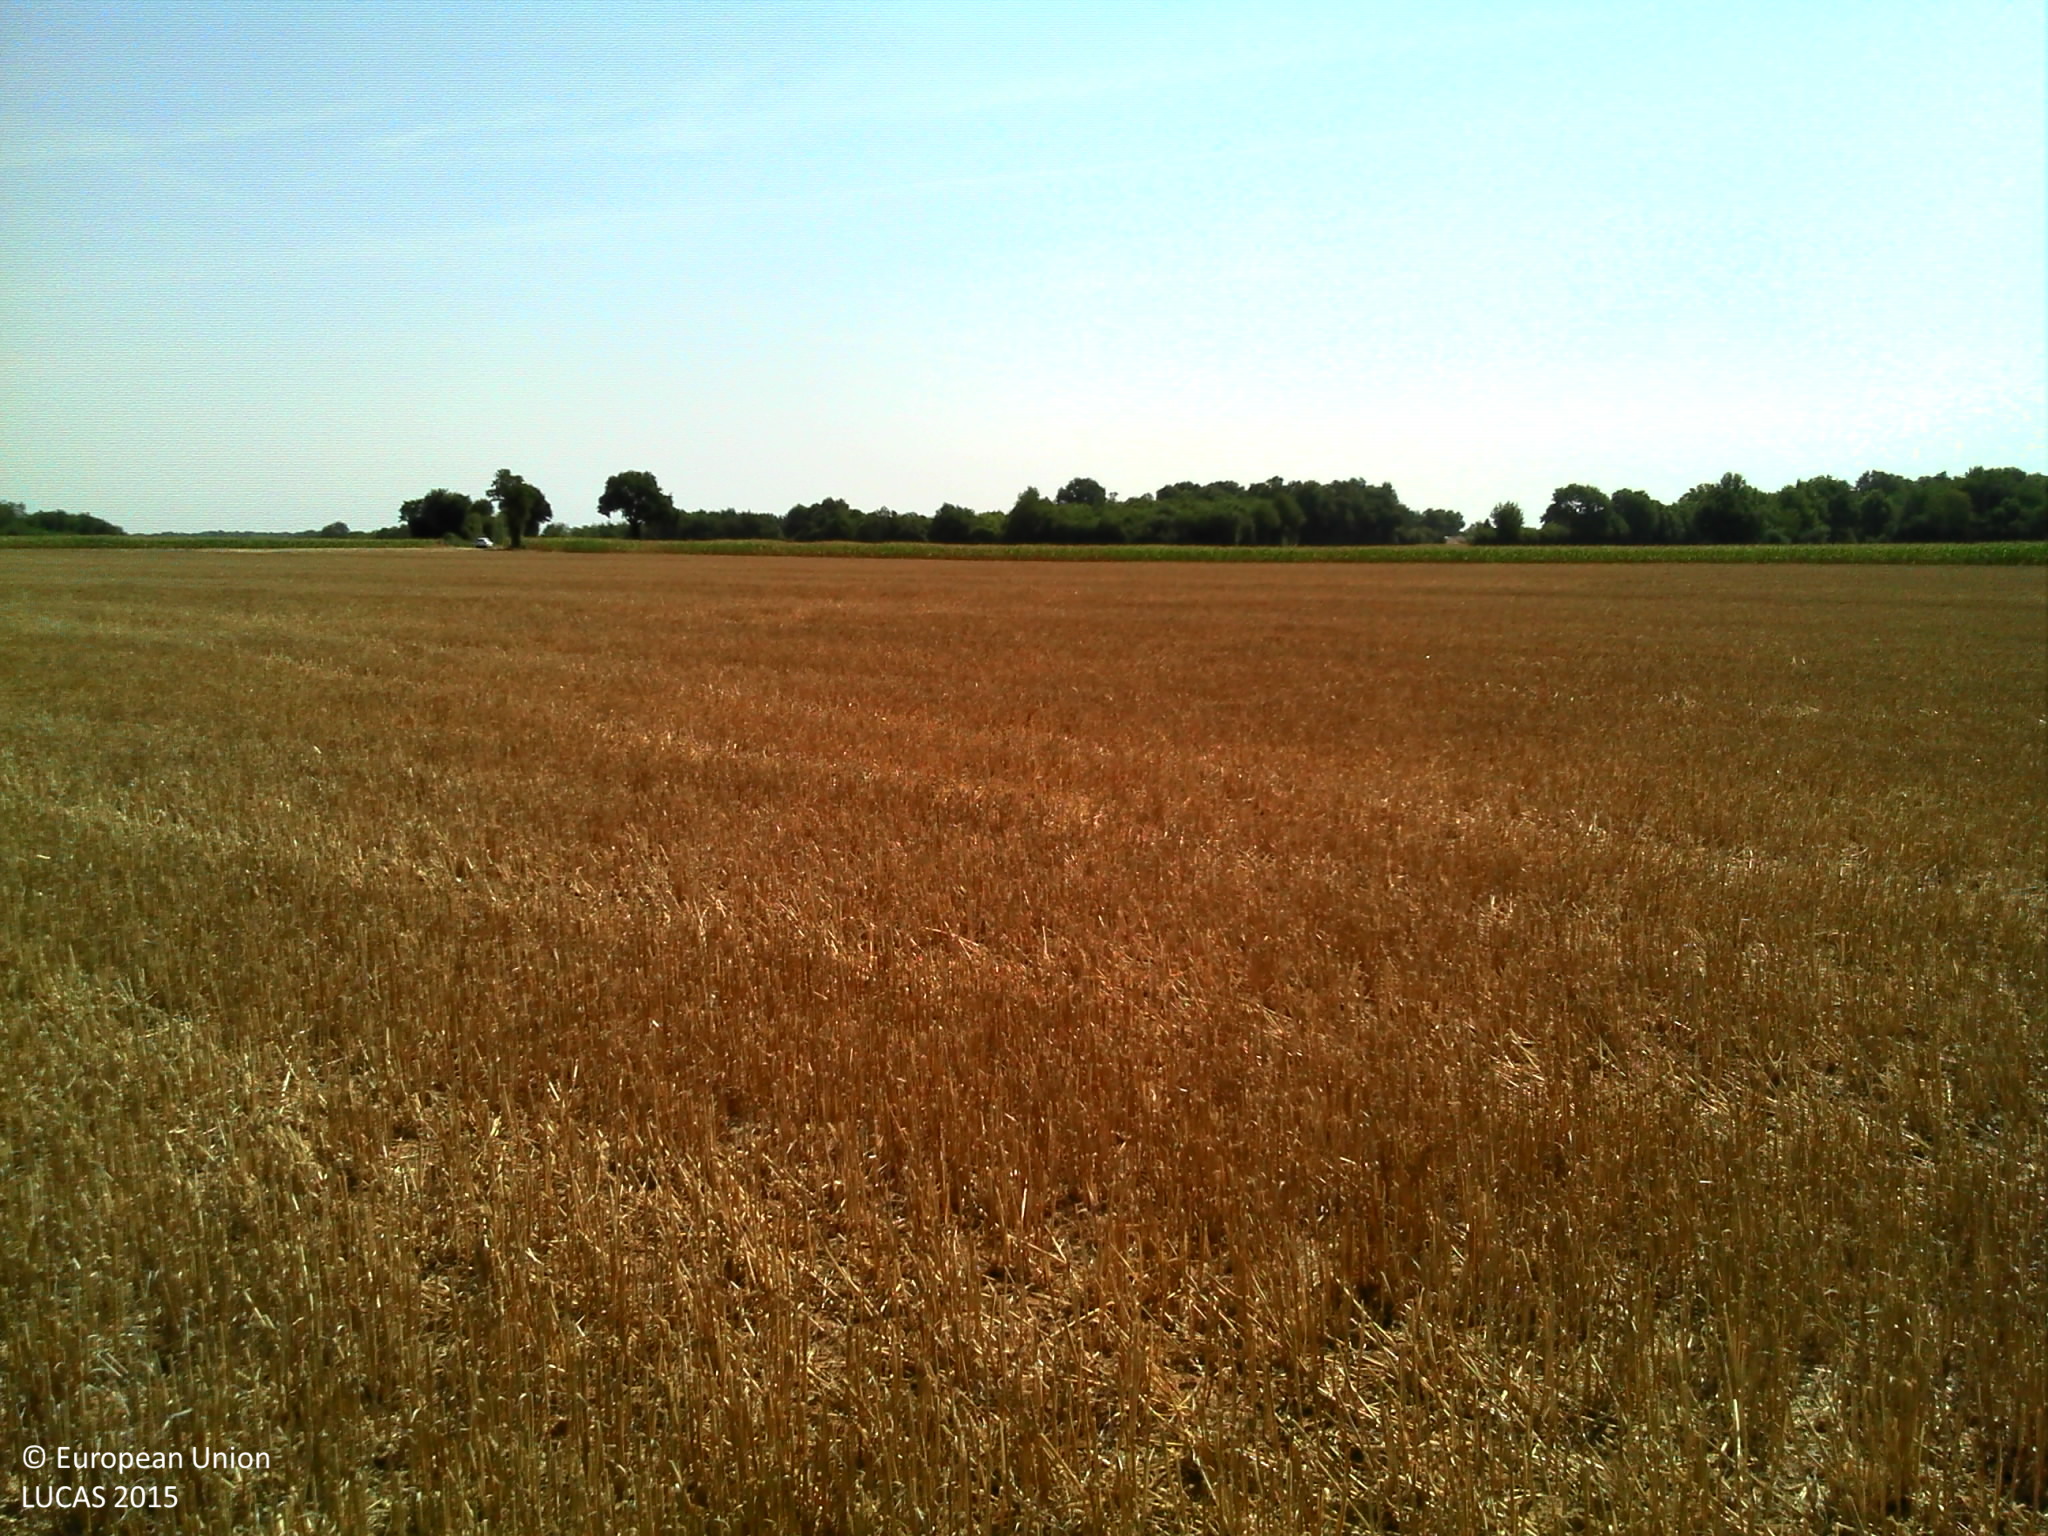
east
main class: Cropland
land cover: Common wheat
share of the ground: > 75 %
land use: Agriculture (excluding fallow land and kitchen gardens)
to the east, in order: Common wheat; Maize
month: August
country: FR
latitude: 46.2222
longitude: 0.3500
